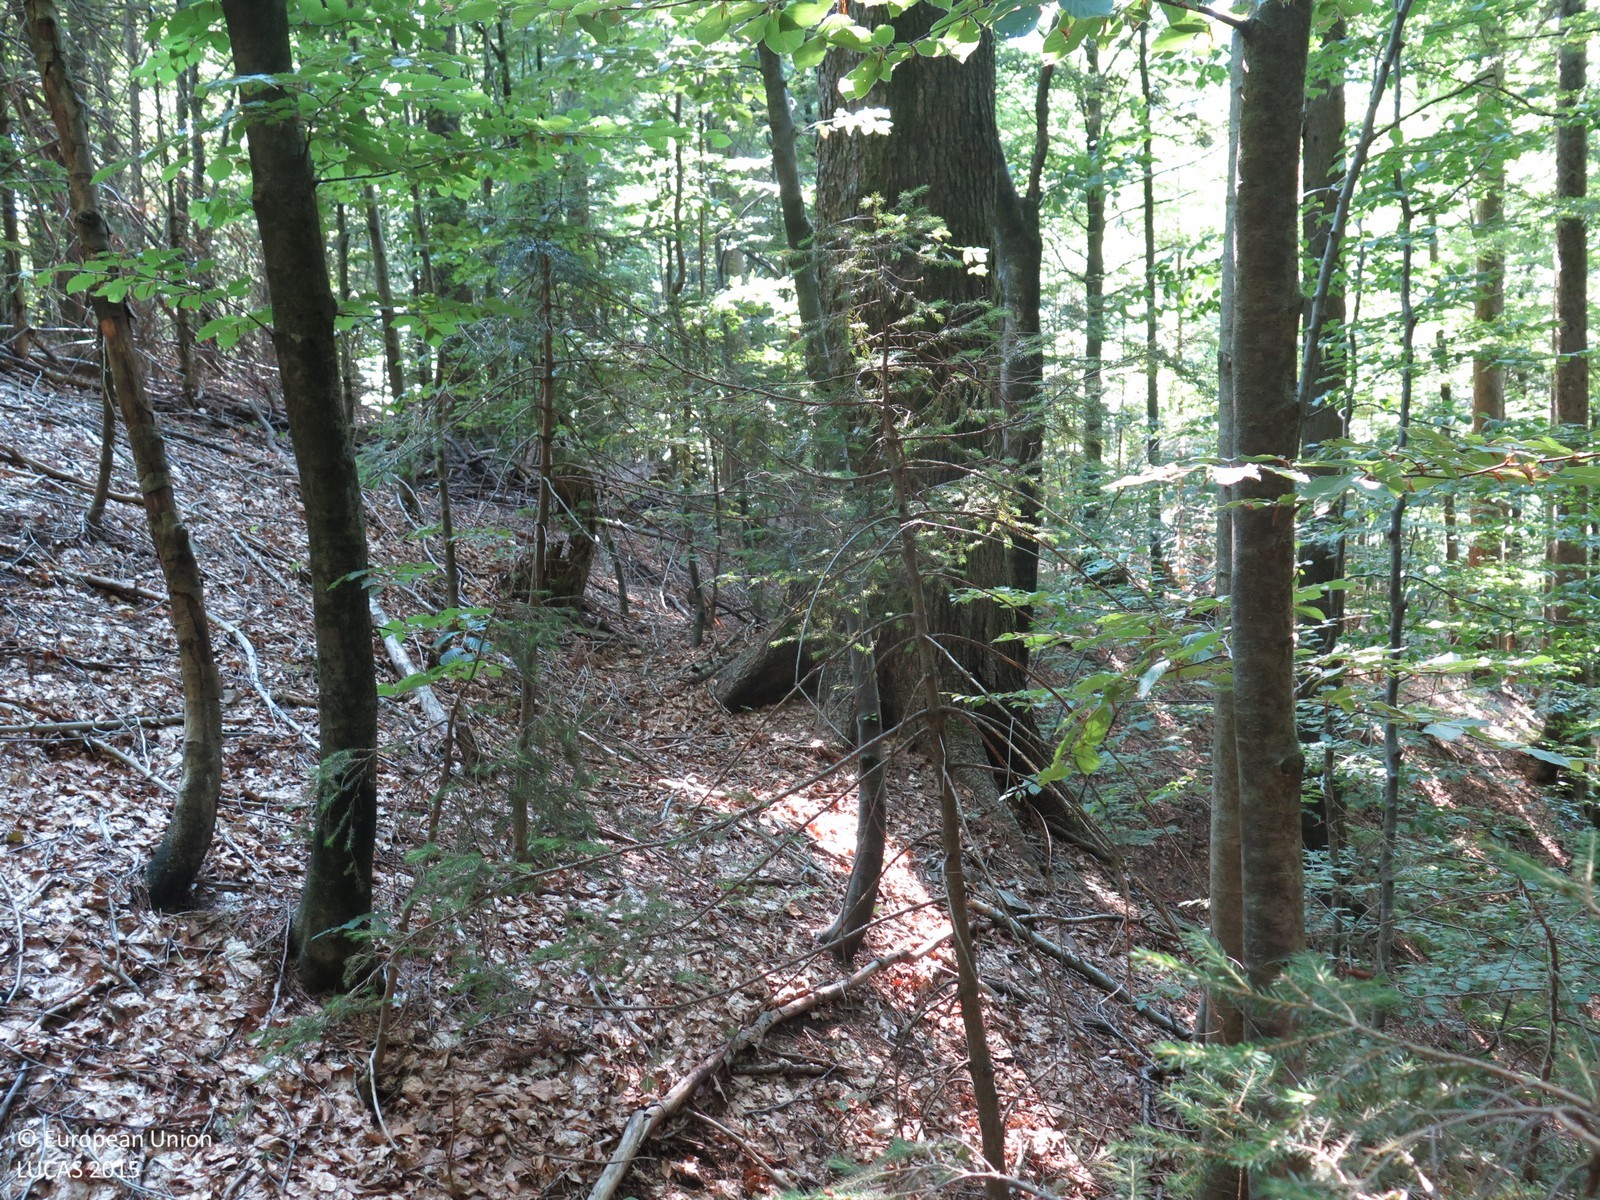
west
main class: Woodland
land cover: Broadleaved woodland
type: beech forest
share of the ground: > 75 %
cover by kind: broadleaved forest trees 100 %
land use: Forestry
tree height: > 5 m
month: August
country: HR
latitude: 45.3477
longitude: 14.6537
